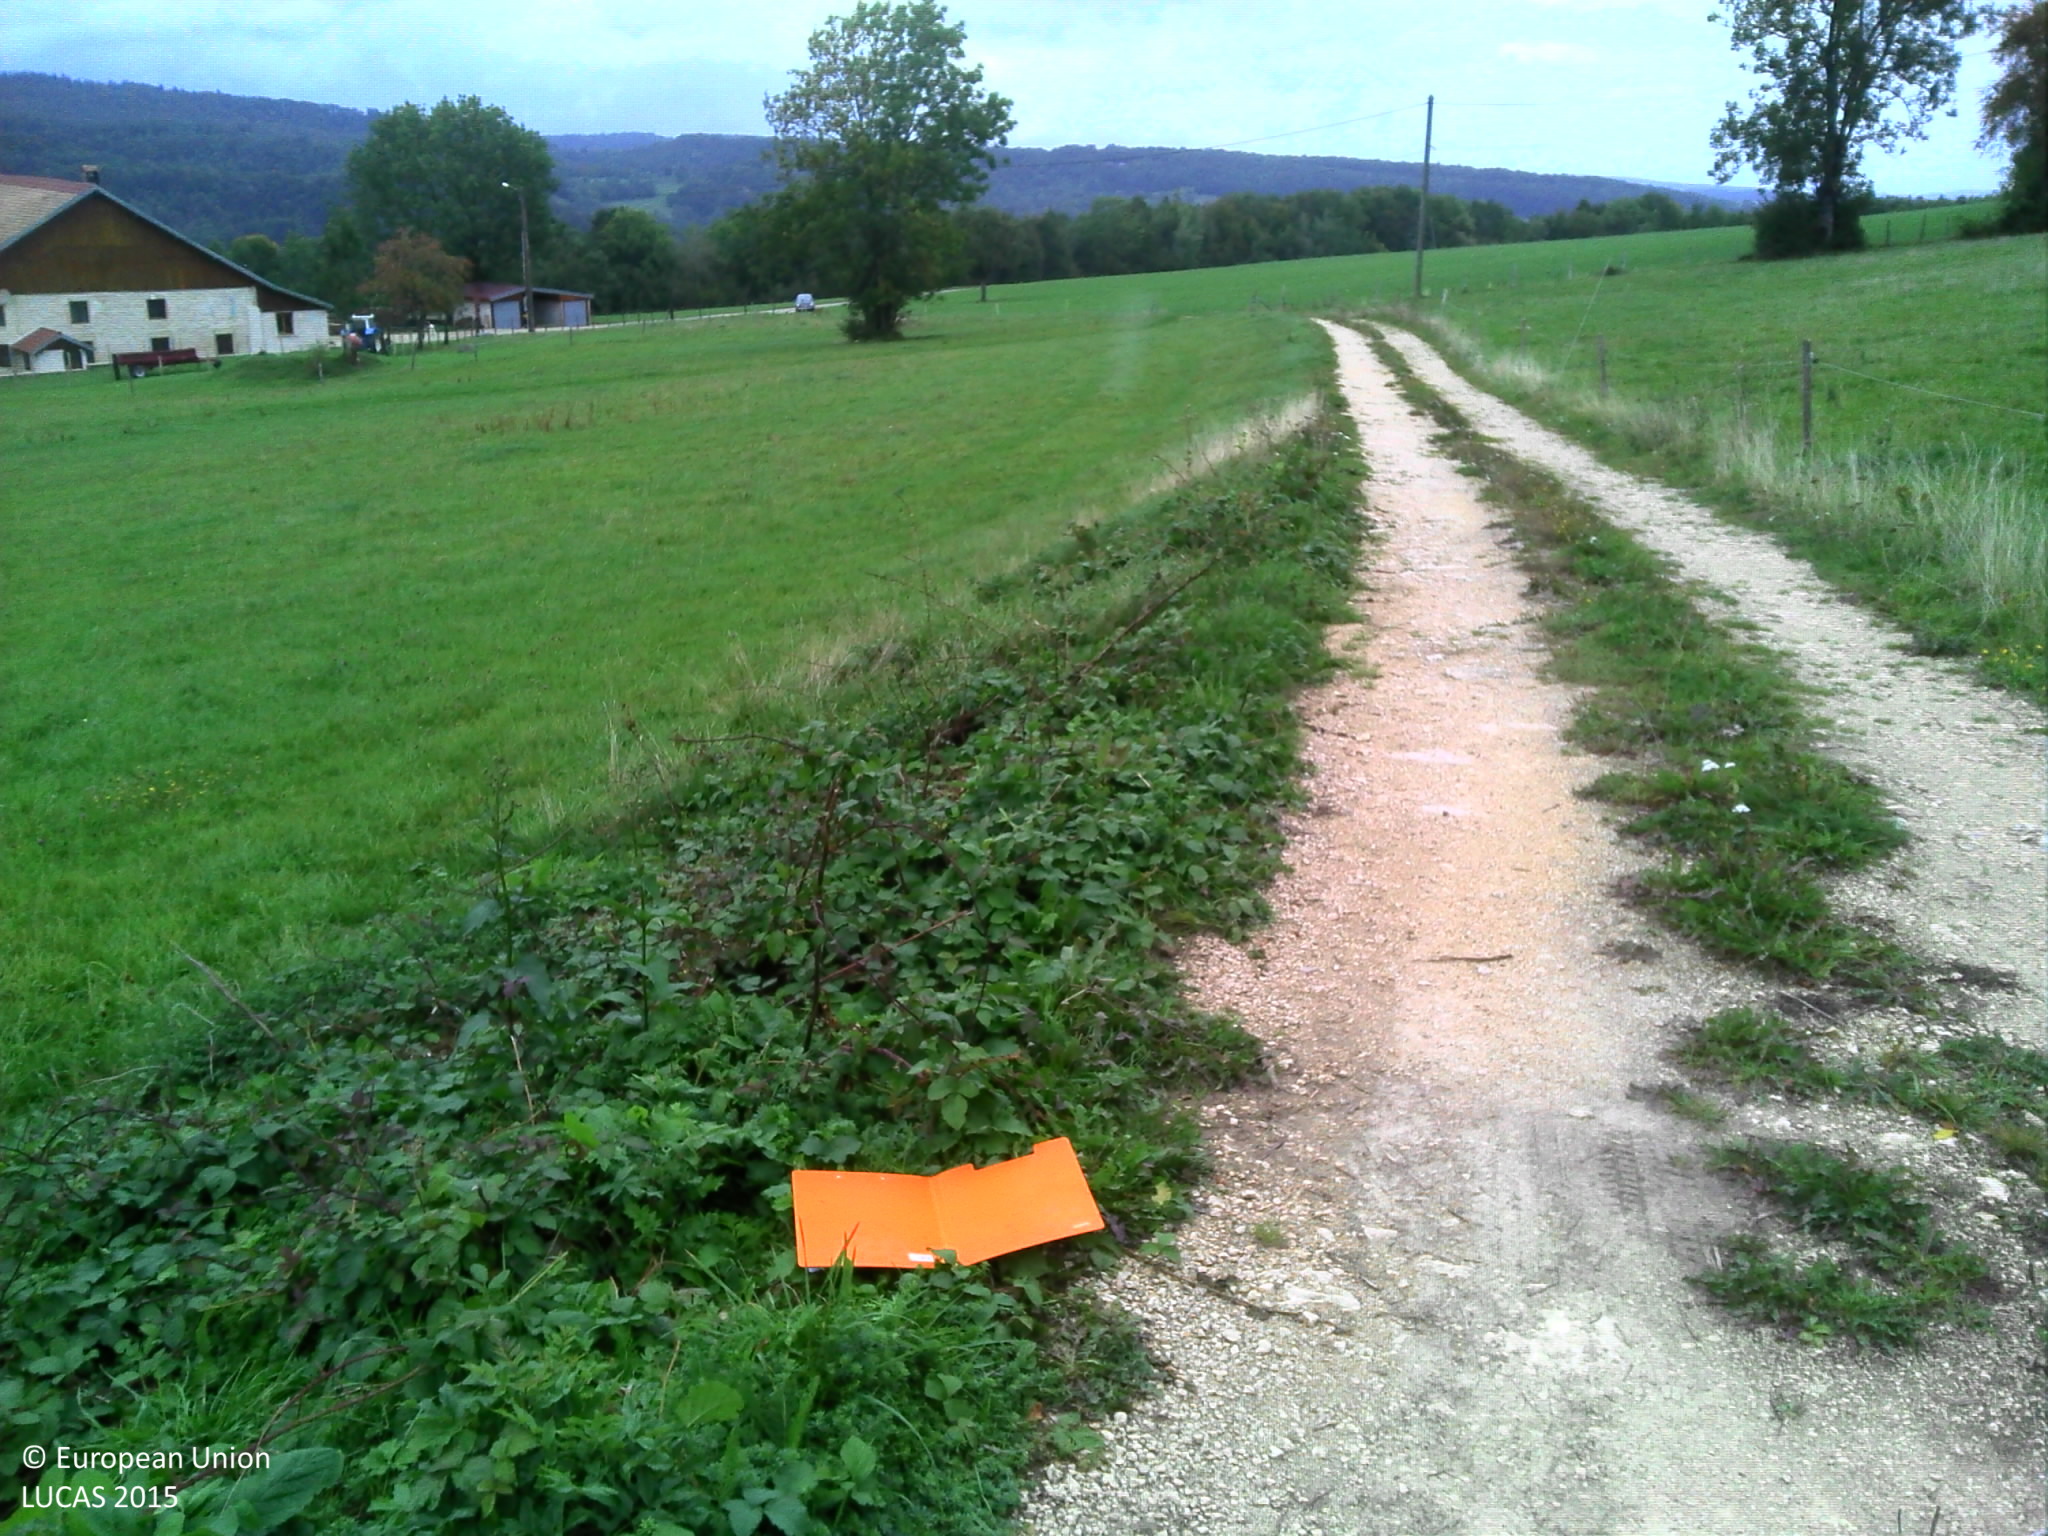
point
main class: Grassland
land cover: Grassland without tree/shrub cover
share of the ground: > 75 %
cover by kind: herbaceous plants 100 %
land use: Agriculture (excluding fallow land and kitchen gardens)
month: September
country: FR
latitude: 47.3332
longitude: 6.8920
